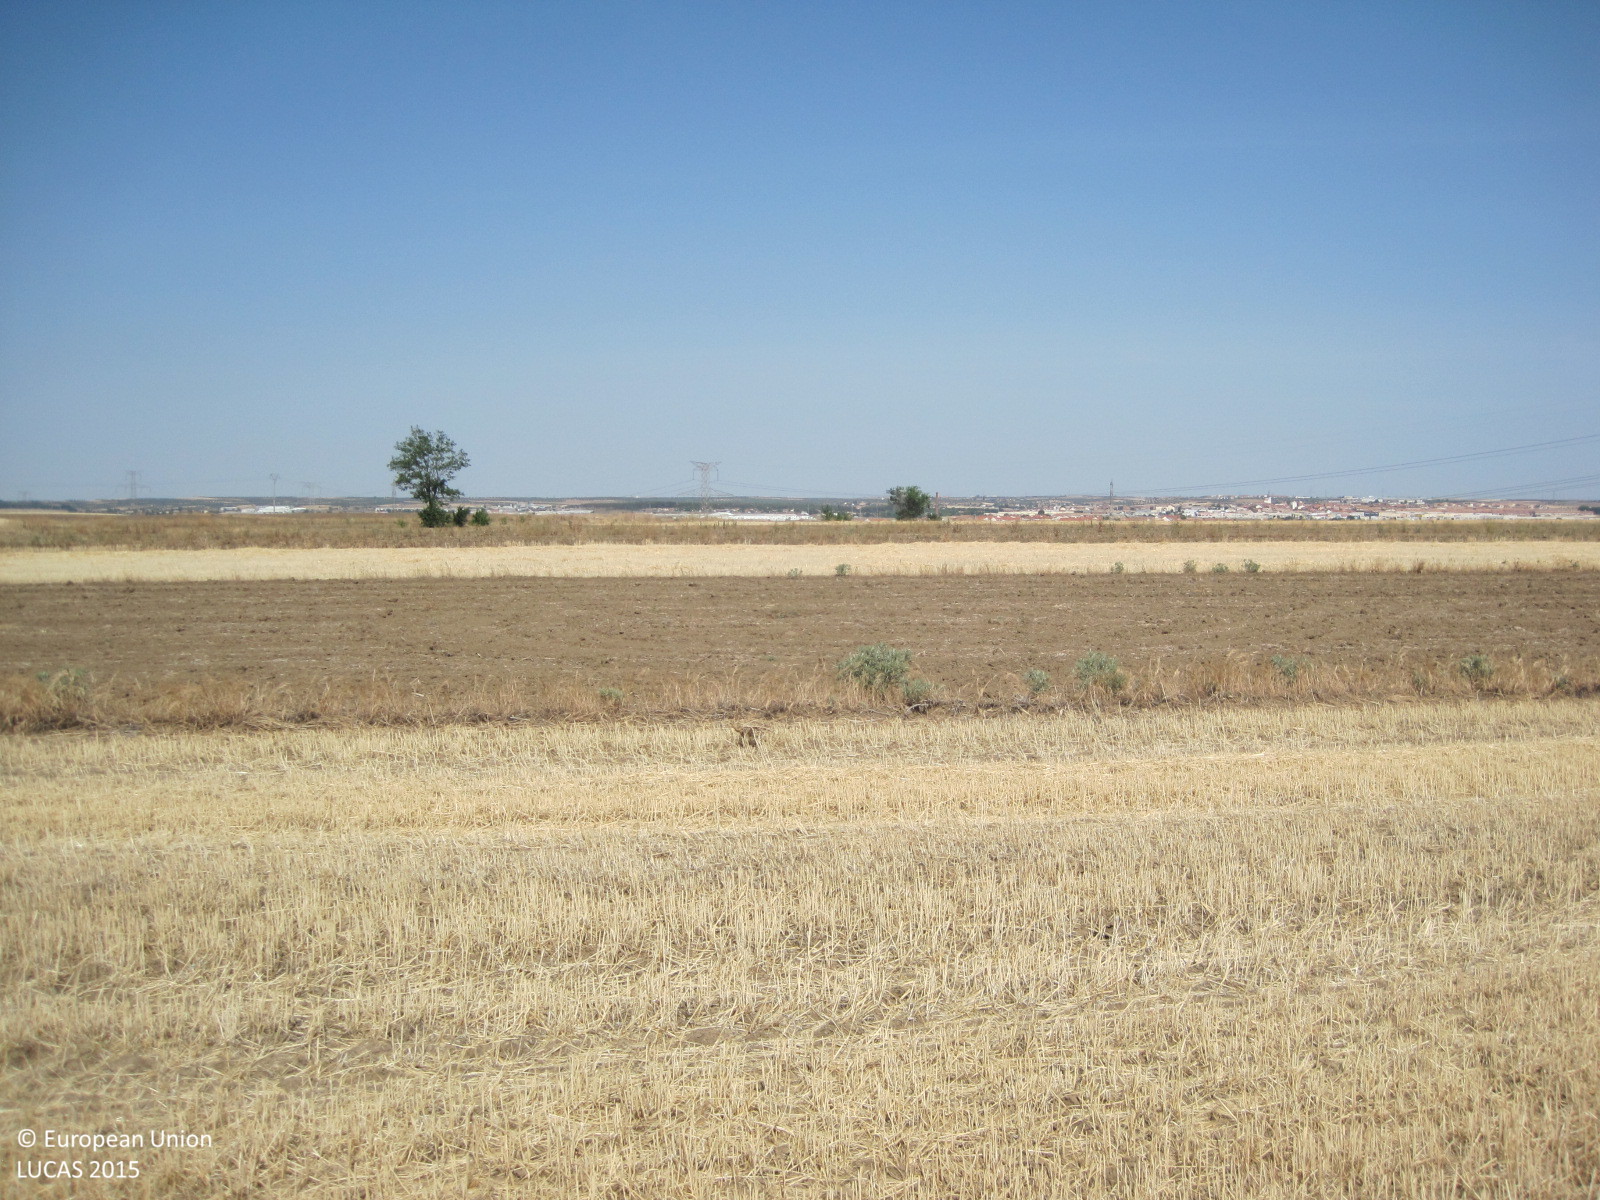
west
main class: Cropland
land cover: Barley
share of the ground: < 10 %
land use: Agriculture (excluding fallow land and kitchen gardens)
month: July
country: ES
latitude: 40.0699
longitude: -3.8353
